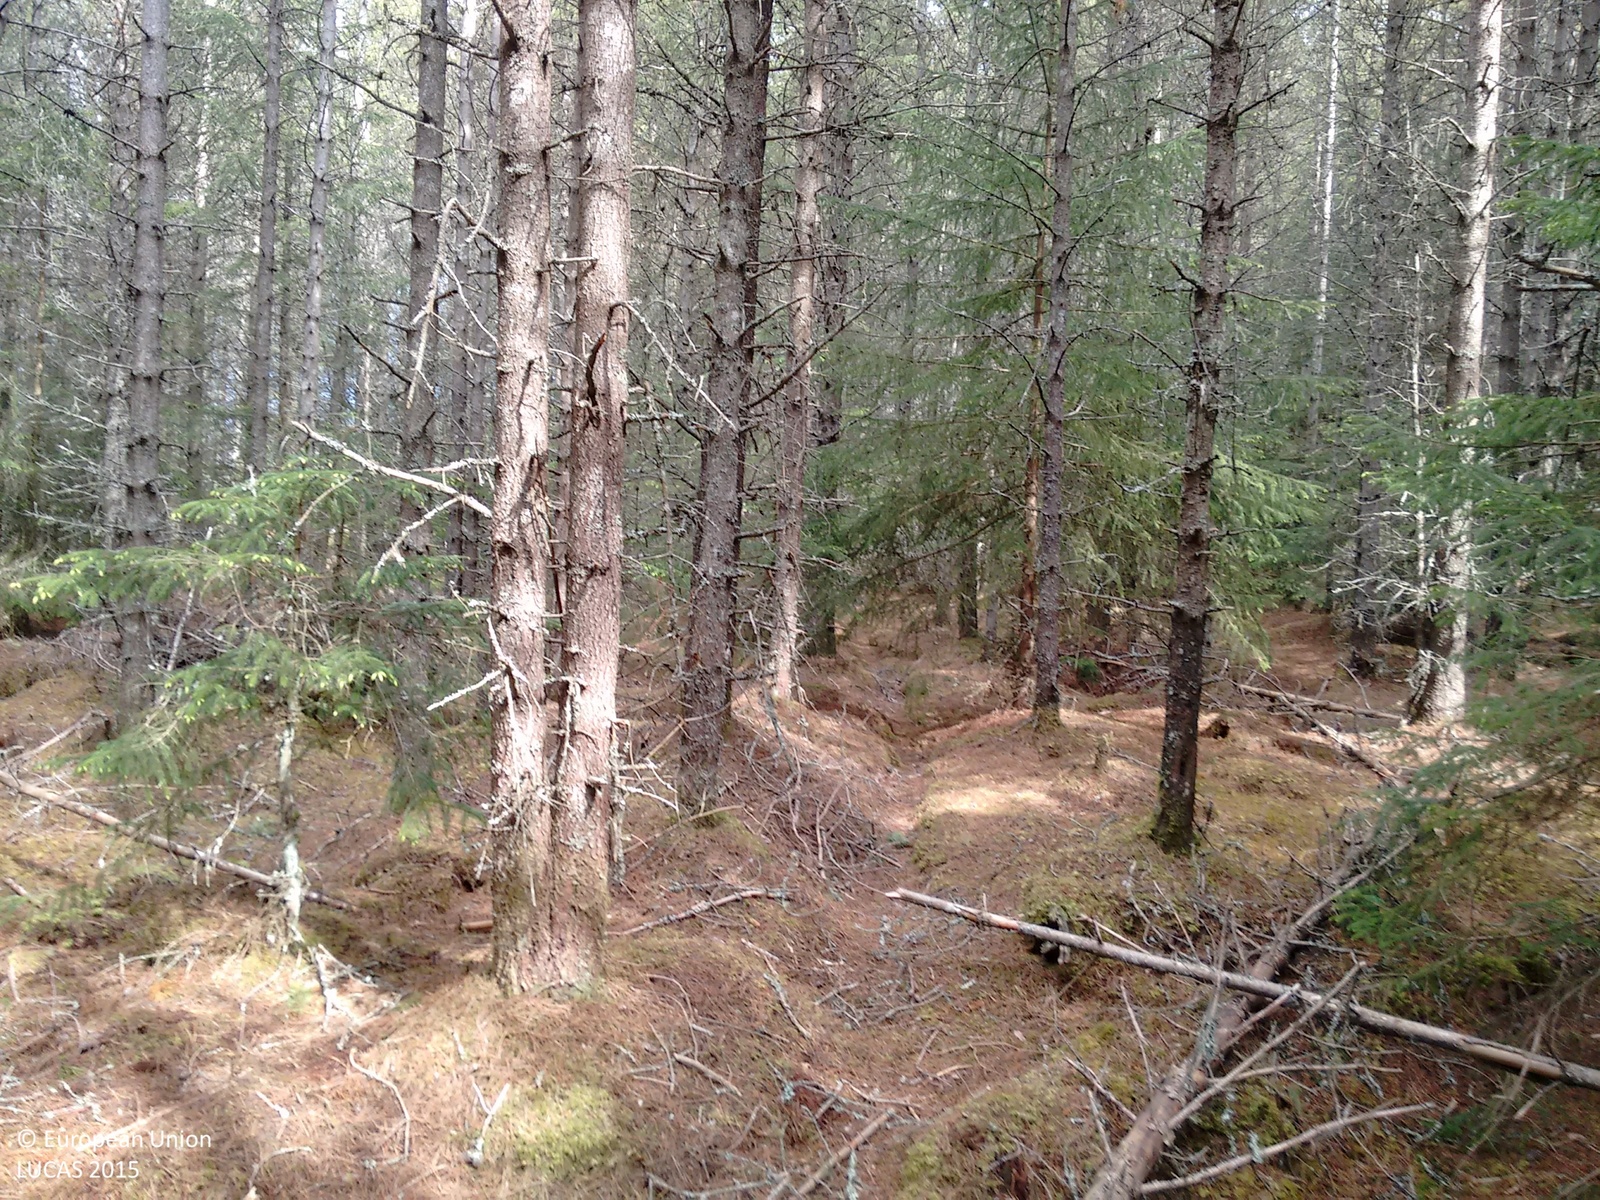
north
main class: Woodland
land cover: Spruce dominated coniferous woodland
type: exotic forest
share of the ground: > 75 %
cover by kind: coniferous forest trees 85 %, lichens and mosses 15 %
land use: Forestry
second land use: Amenities, museums, leisure
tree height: > 5 m
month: June
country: GB
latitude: 57.1816
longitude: -3.7247
